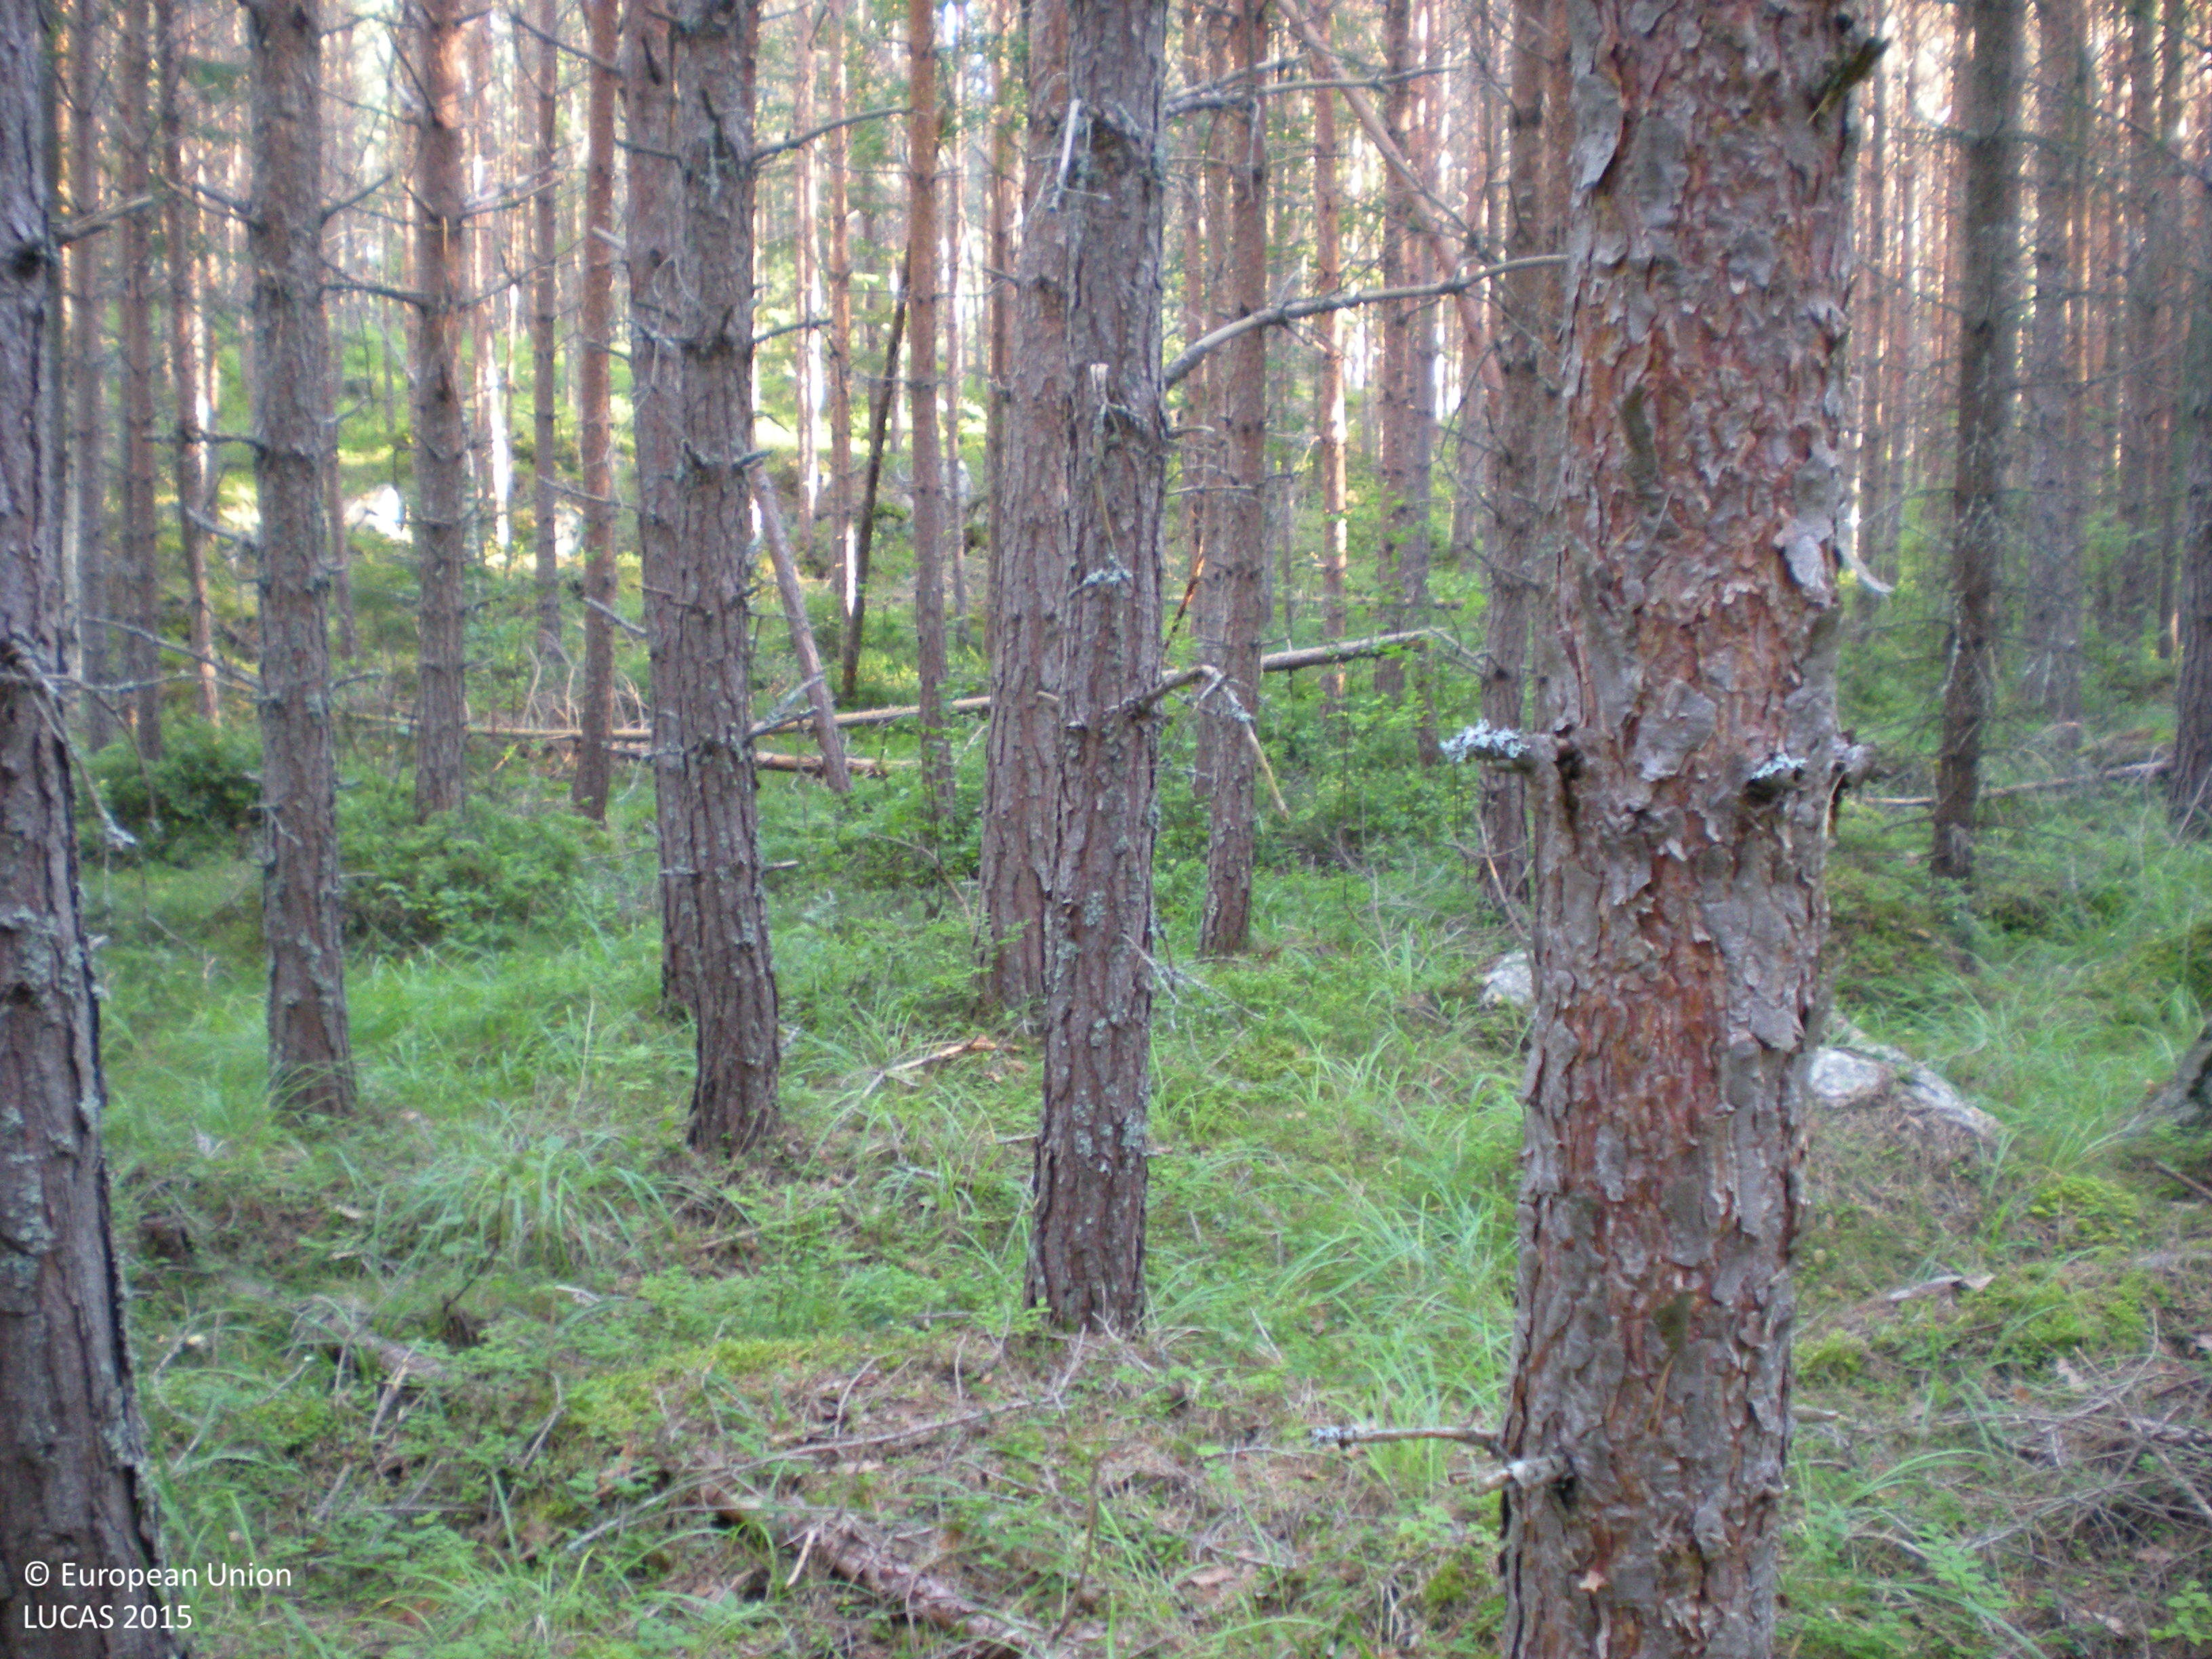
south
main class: Woodland
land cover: Pine dominated coniferous woodland
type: boreal forest
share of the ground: > 75 %
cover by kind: coniferous forest trees 85 %, shrubs 5 %, herbaceous plants 5 %, lichens and mosses 5 %
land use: Forestry
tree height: > 5 m
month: August
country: SE
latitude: 60.6830
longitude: 16.8542
